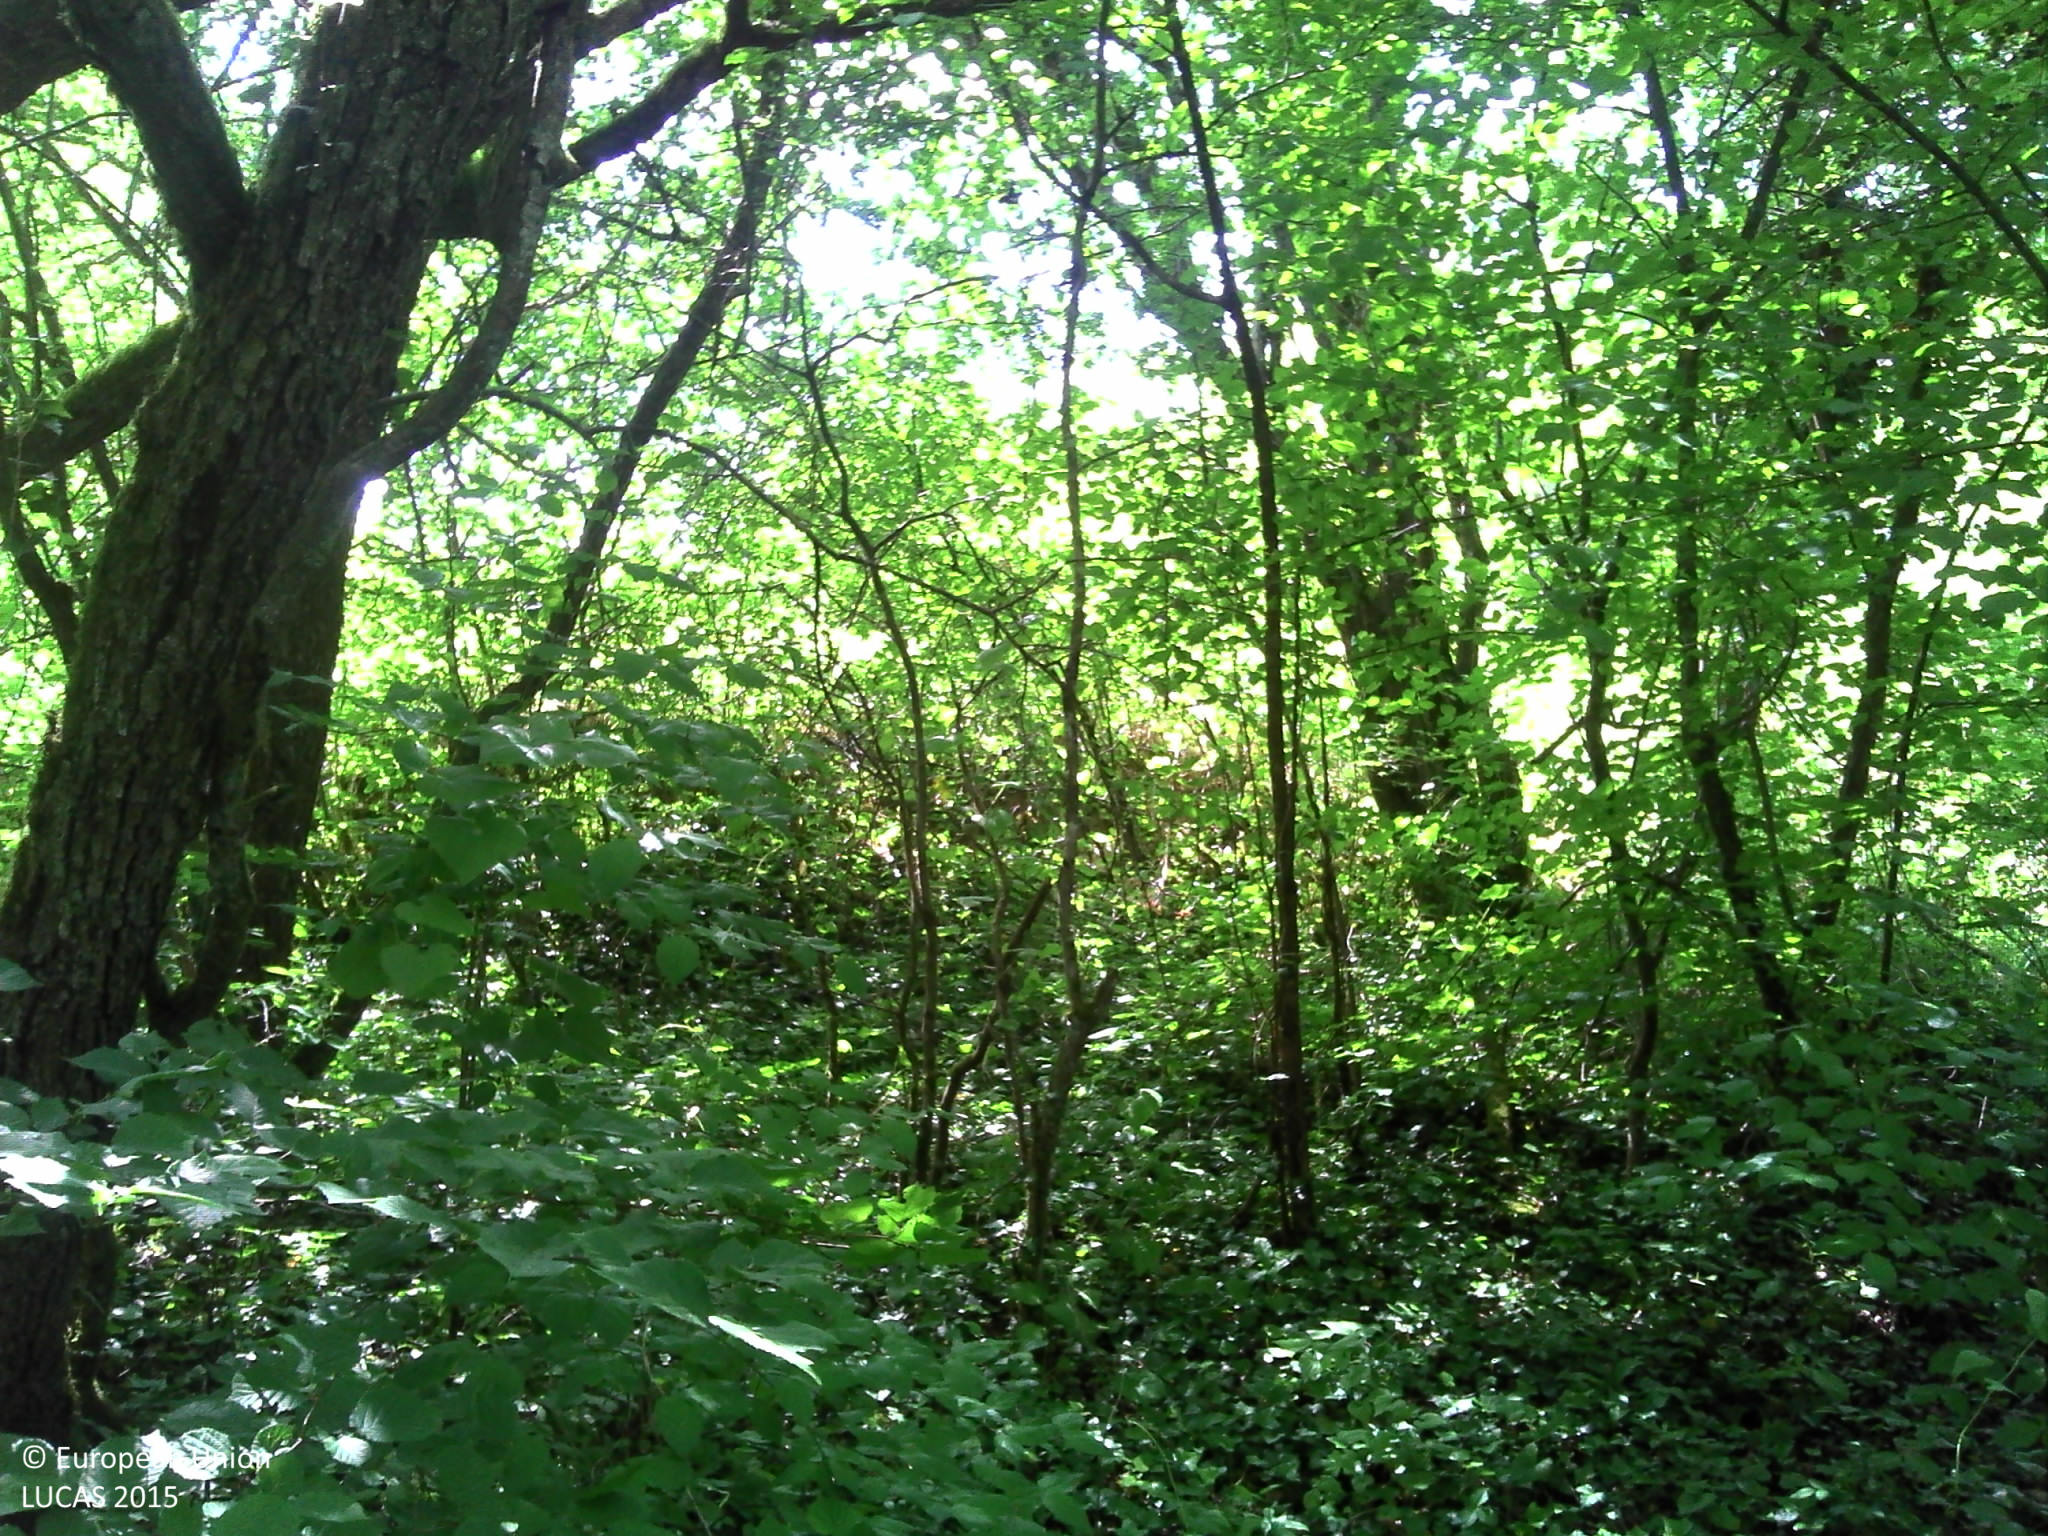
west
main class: Woodland
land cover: Broadleaved woodland
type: mesophytic deciduous forest
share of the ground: > 75 %
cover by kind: broadleaved forest trees 90 %, herbaceous plants 5 %, lichens and mosses 5 %
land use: Forestry
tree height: > 5 m
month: May
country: FR
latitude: 47.8232
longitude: 4.2944
